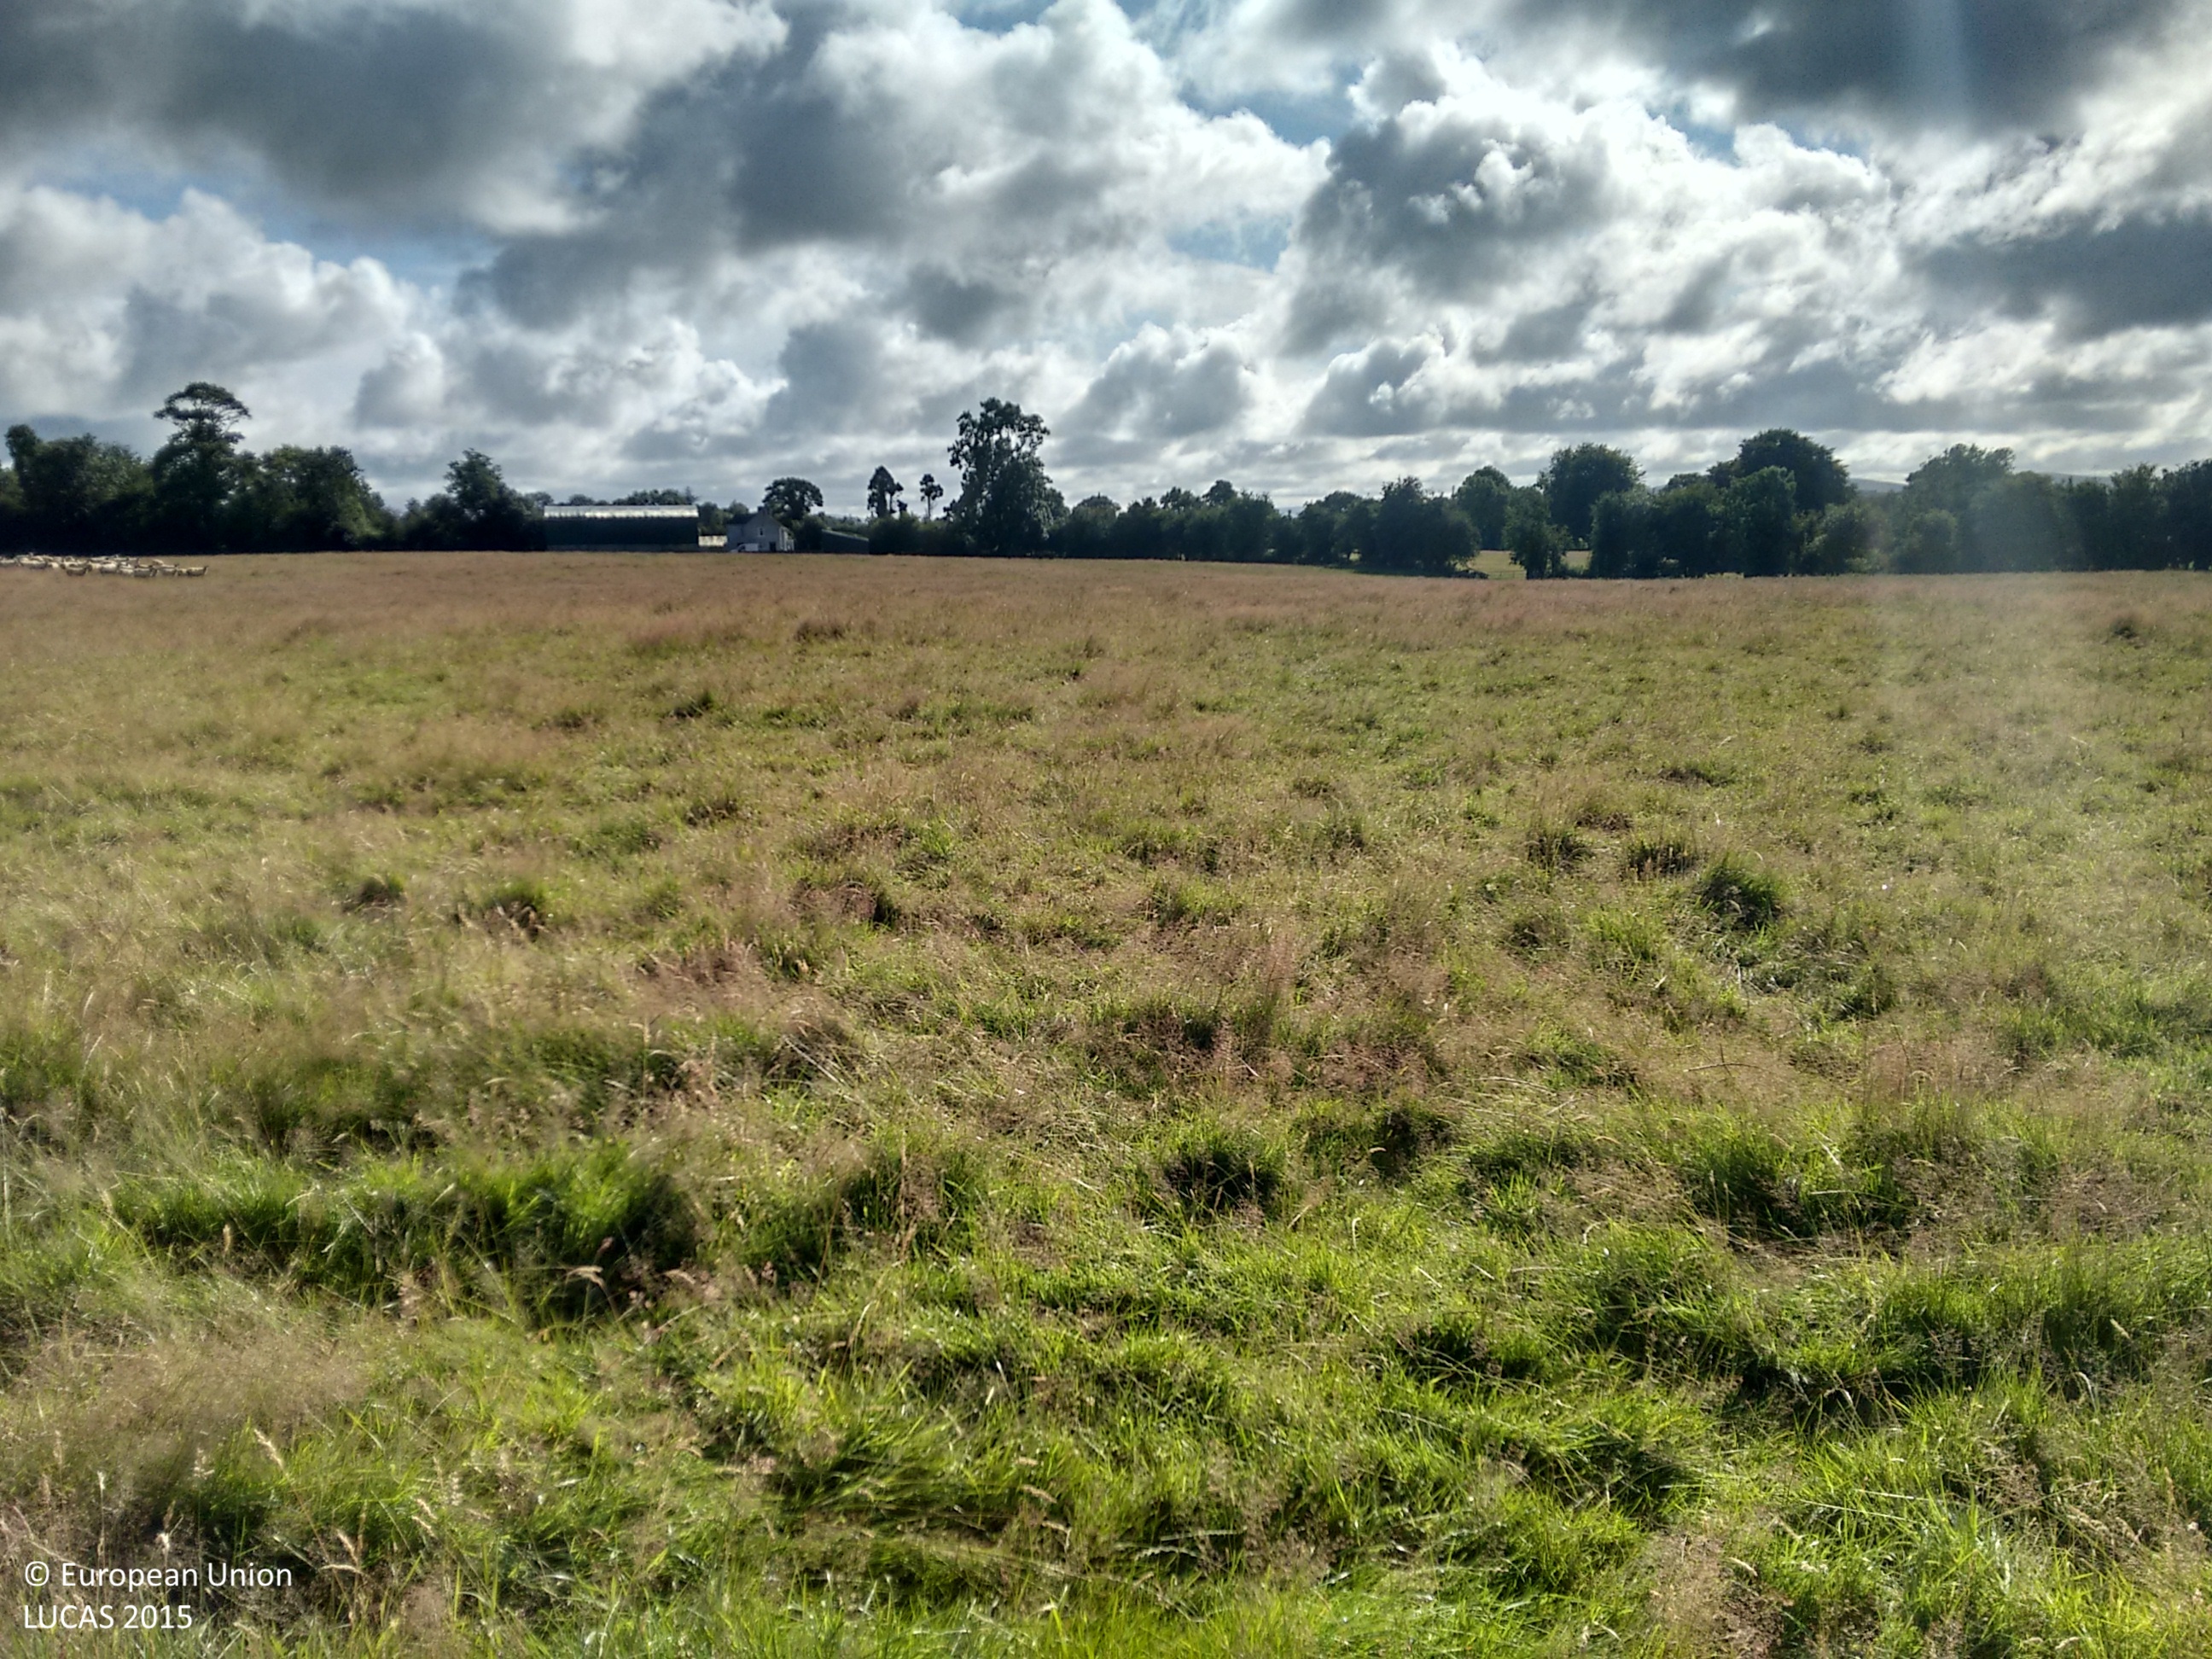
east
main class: Grassland
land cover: Grassland without tree/shrub cover
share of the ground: > 75 %
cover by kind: herbaceous plants 100 %
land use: Agriculture (excluding fallow land and kitchen gardens)
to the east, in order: Grassland without tree/shrub cover; Fences; Grassland without tree/shrub cover; Fences; Grassland without tree/shrub cover; Abandoned hedges; Grassland without tree/shrub cover
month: July
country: IE
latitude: 52.8132
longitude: -6.7367
